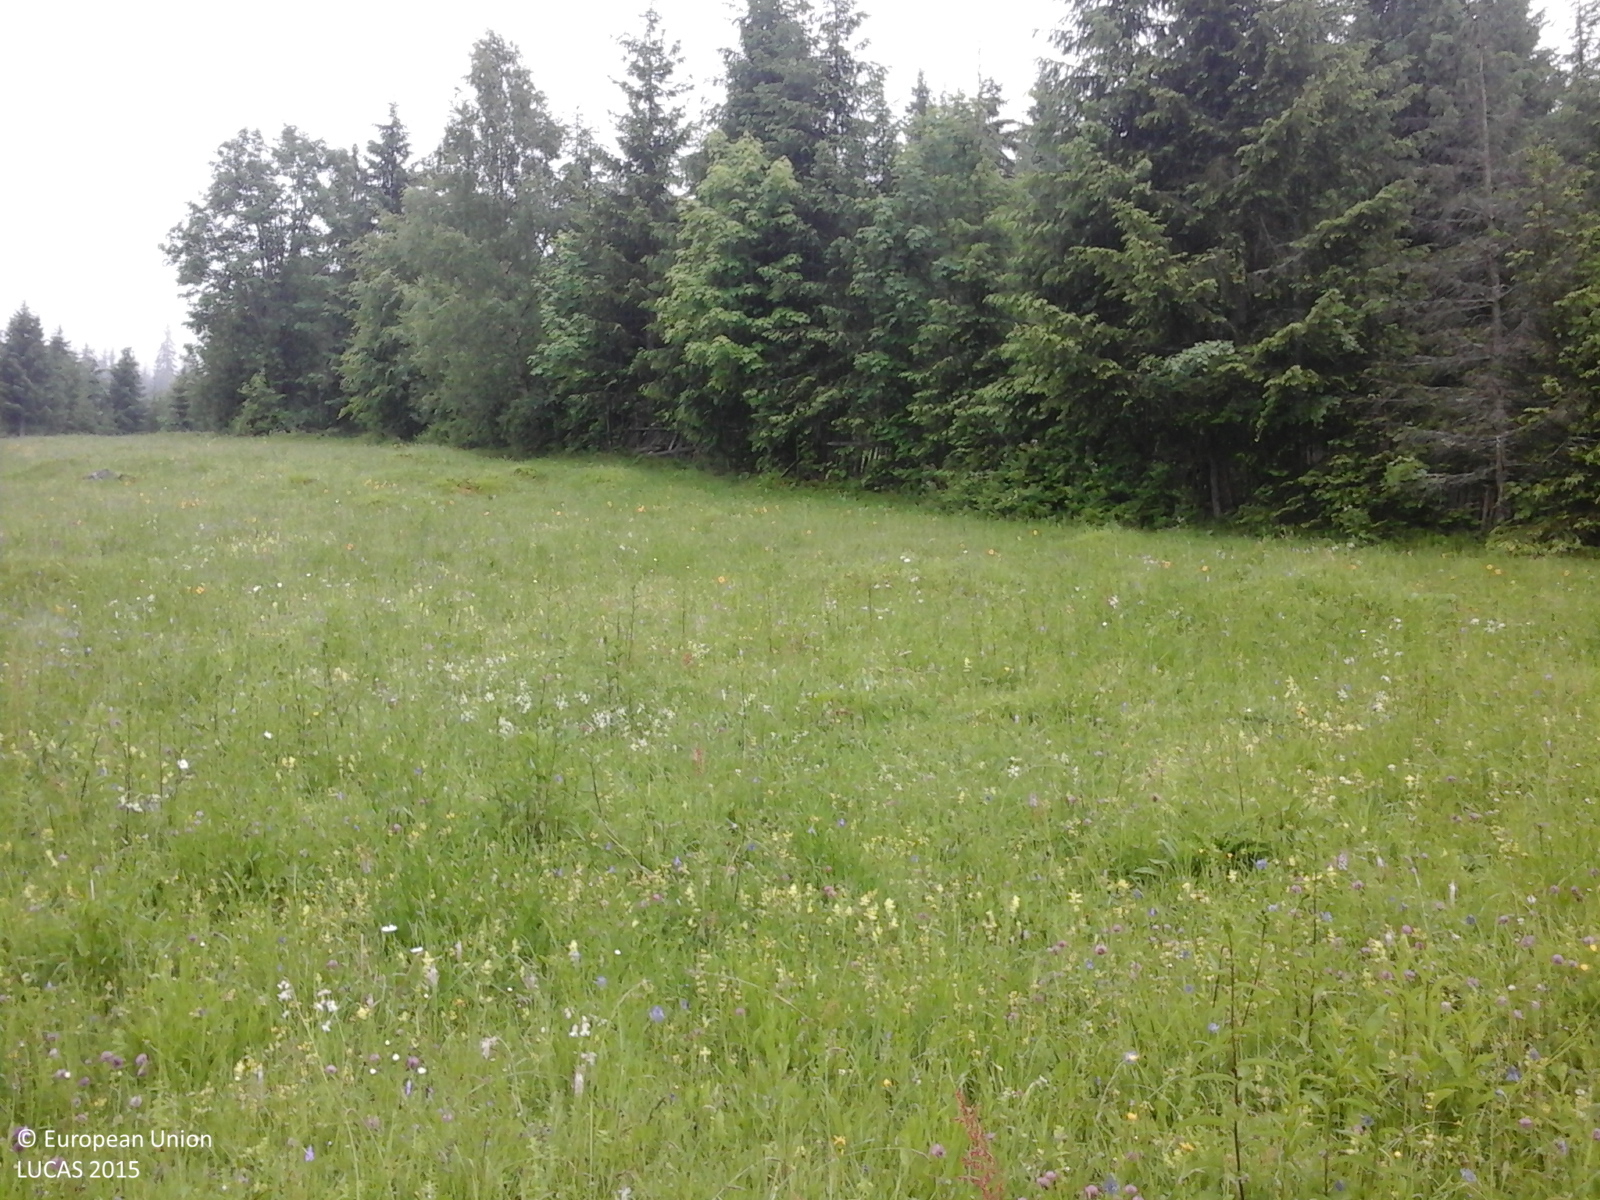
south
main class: Grassland
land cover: Grassland without tree/shrub cover
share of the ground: > 75 %
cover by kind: herbaceous plants 100 %
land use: Agriculture (excluding fallow land and kitchen gardens)
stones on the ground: < 10 %
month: June
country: RO
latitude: 47.2156
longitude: 25.3346
